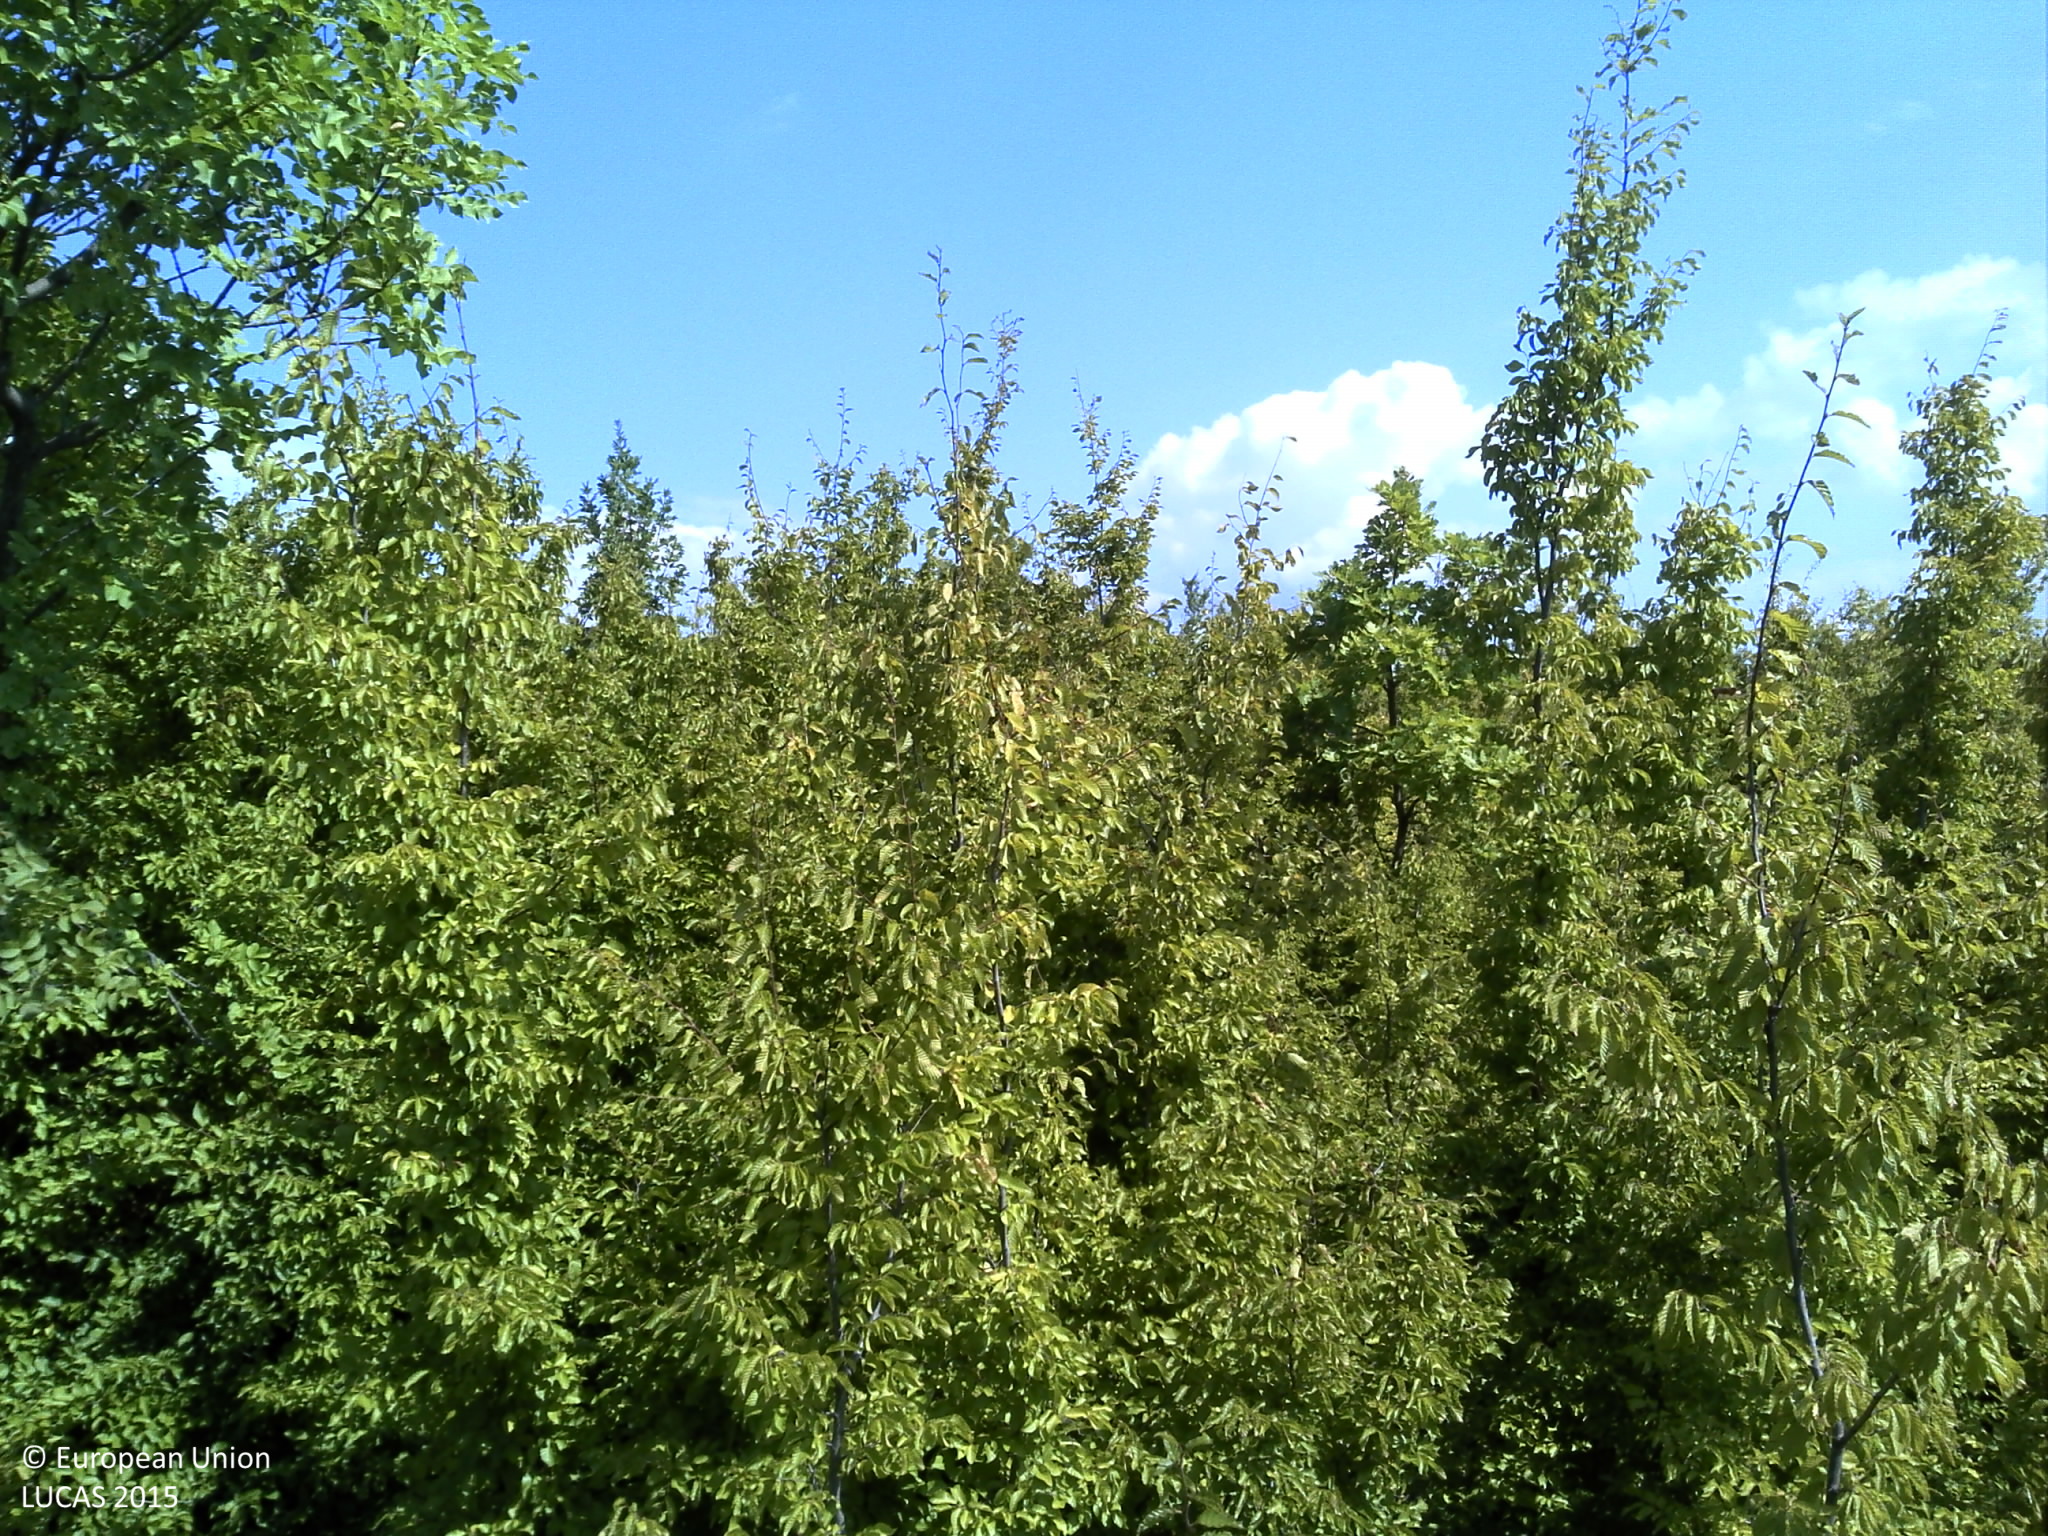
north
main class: Woodland
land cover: Broadleaved woodland
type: thermophilous deciduous forest
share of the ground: > 75 %
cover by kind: shrubs 40 %, broadleaved forest trees 30 %, herbaceous plants 10 %, consolidated bare surface 10 %, unconsolidated bare surface 10 %
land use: Semi-natural and natural areas not in use
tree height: > 5 m
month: August
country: HR
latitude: 44.0743
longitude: 15.8984
